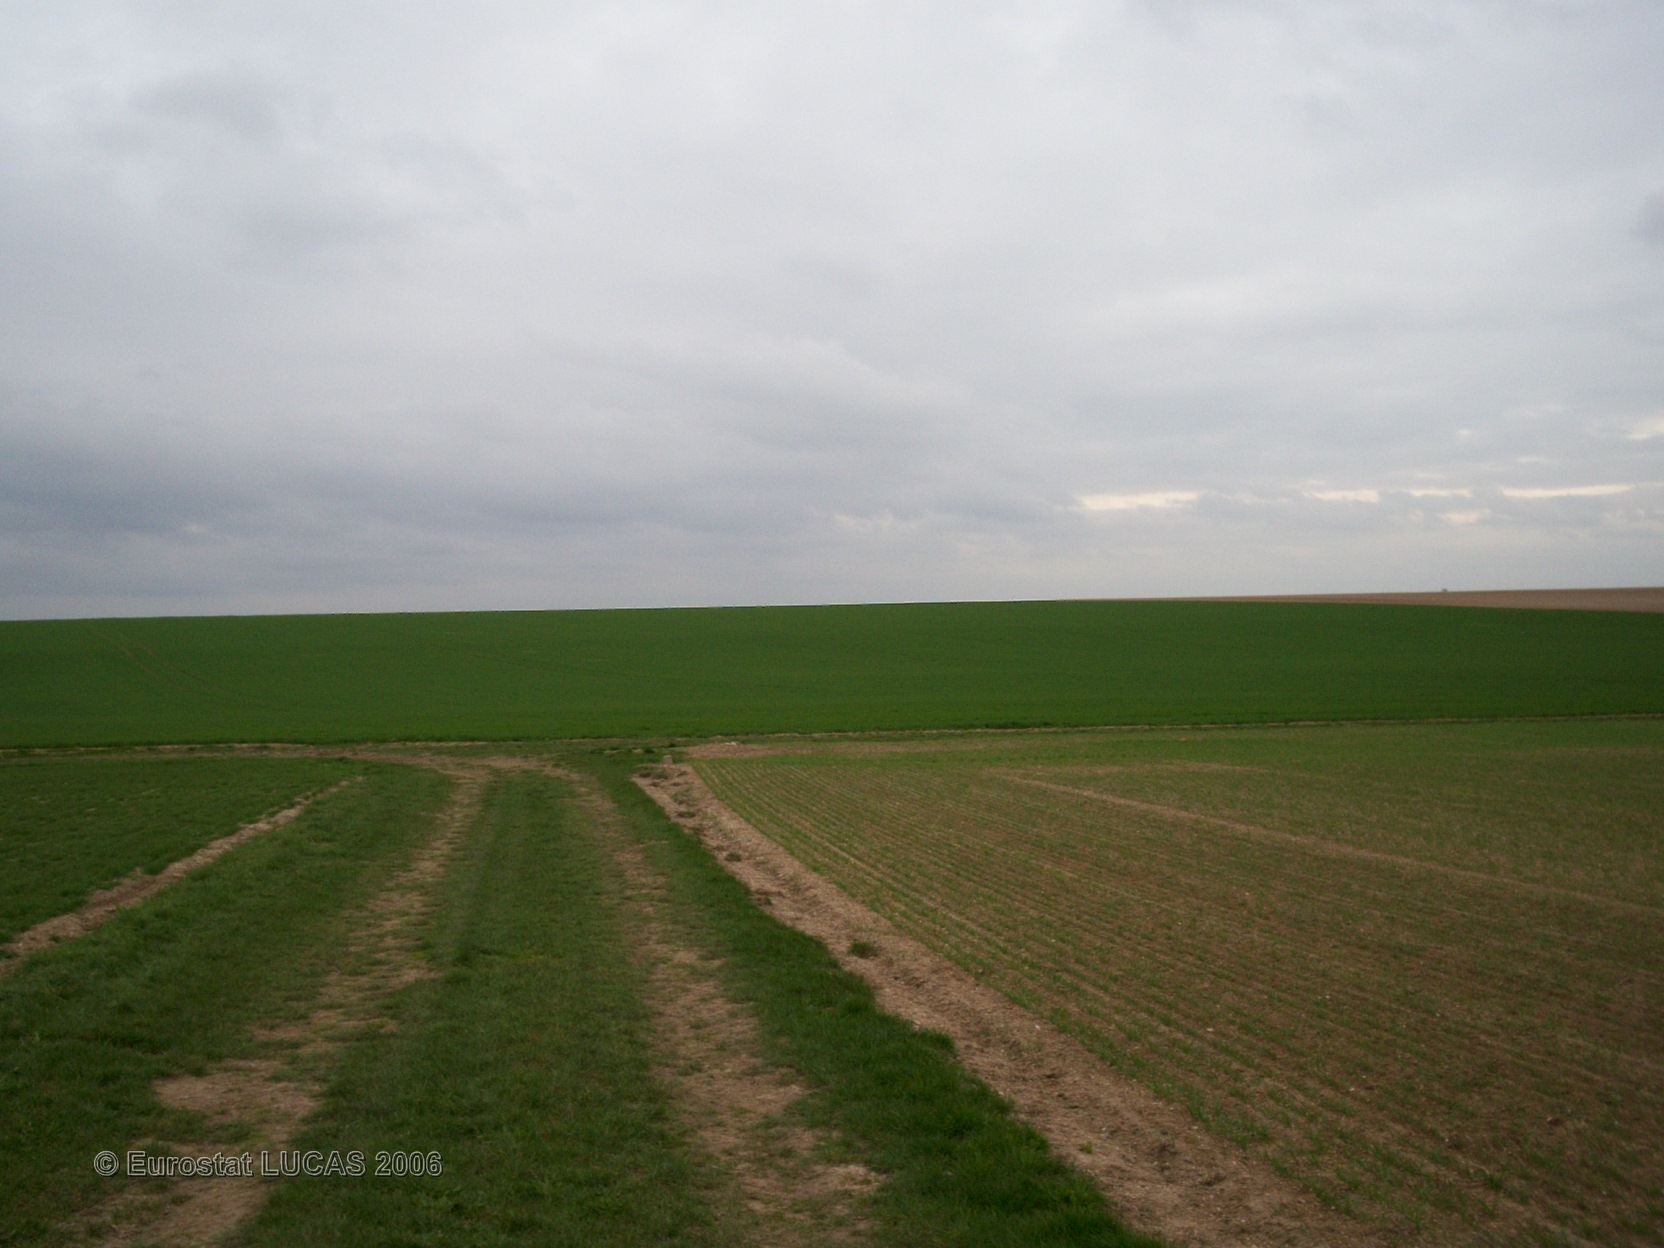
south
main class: Cropland
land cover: Barley
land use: Agriculture (excluding fallow land and kitchen gardens)
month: April
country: FR
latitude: 49.2191
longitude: 4.4359
